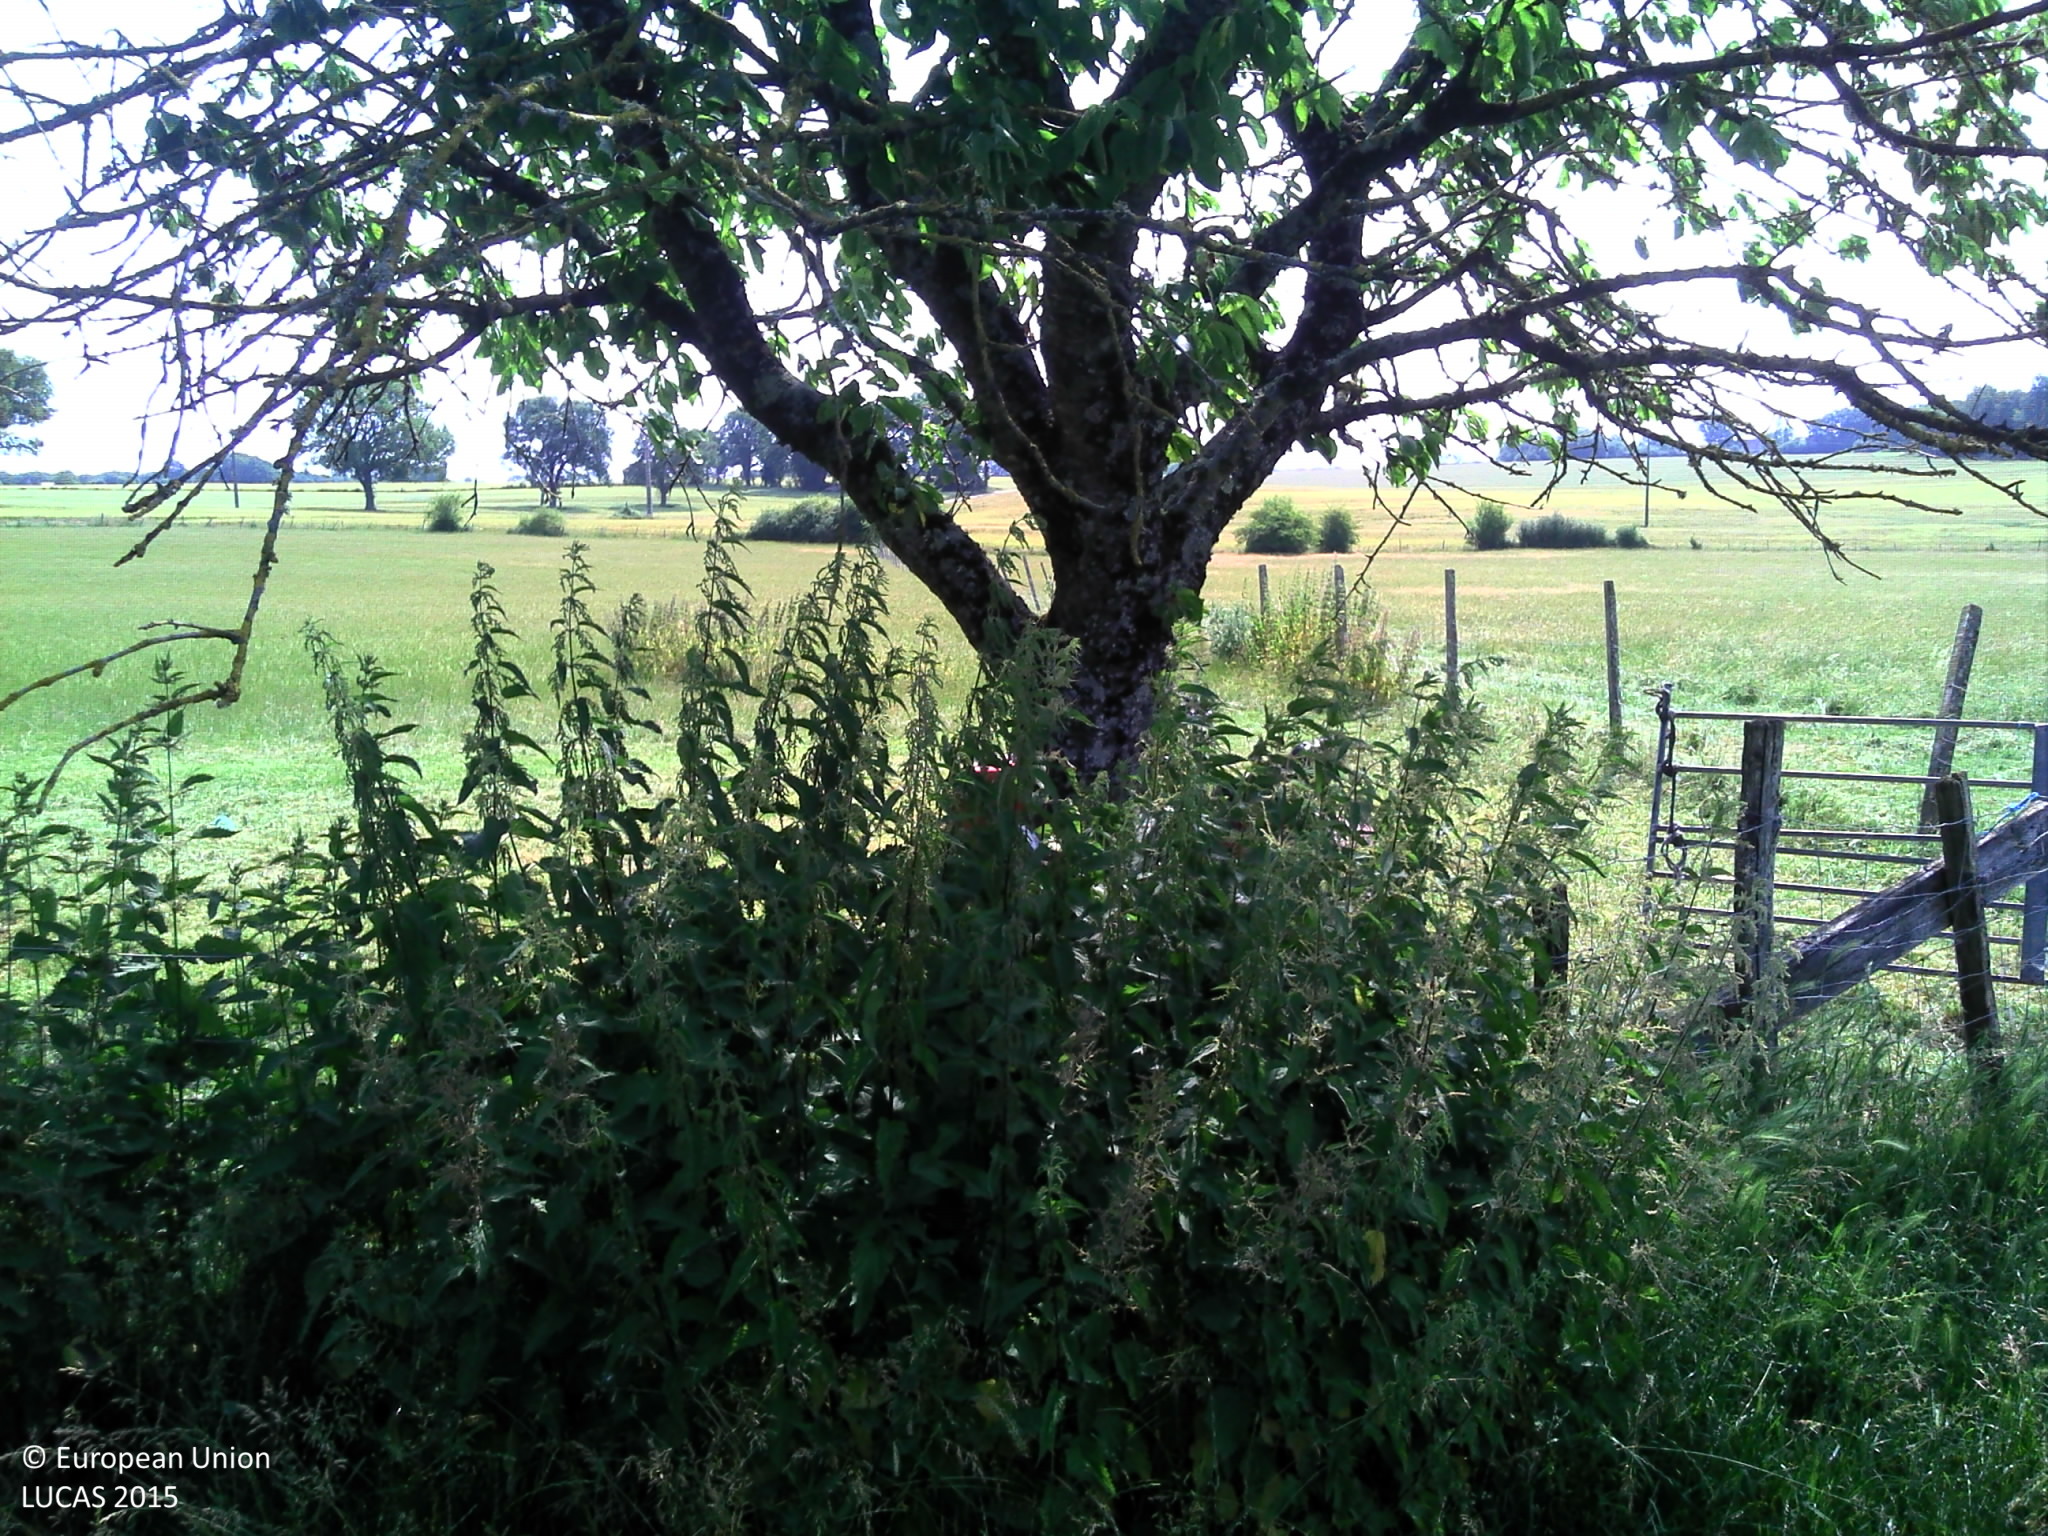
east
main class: Grassland
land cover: Grassland with sparse tree/shrub cover
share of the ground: > 75 %
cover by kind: herbaceous plants 95 %, broadleaved forest trees 5 %
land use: Agriculture (excluding fallow land and kitchen gardens)
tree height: > 5 m
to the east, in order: Grassland with sparse tree/shrub cover; Fences; Grassland without tree/shrub cover; Fences; Grassland without tree/shrub cover; Single bushes/trees; Grassland without tree/shrub cover; Fences; Grass margins; Common wheat
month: June
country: FR
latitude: 46.6649
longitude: 0.8488
